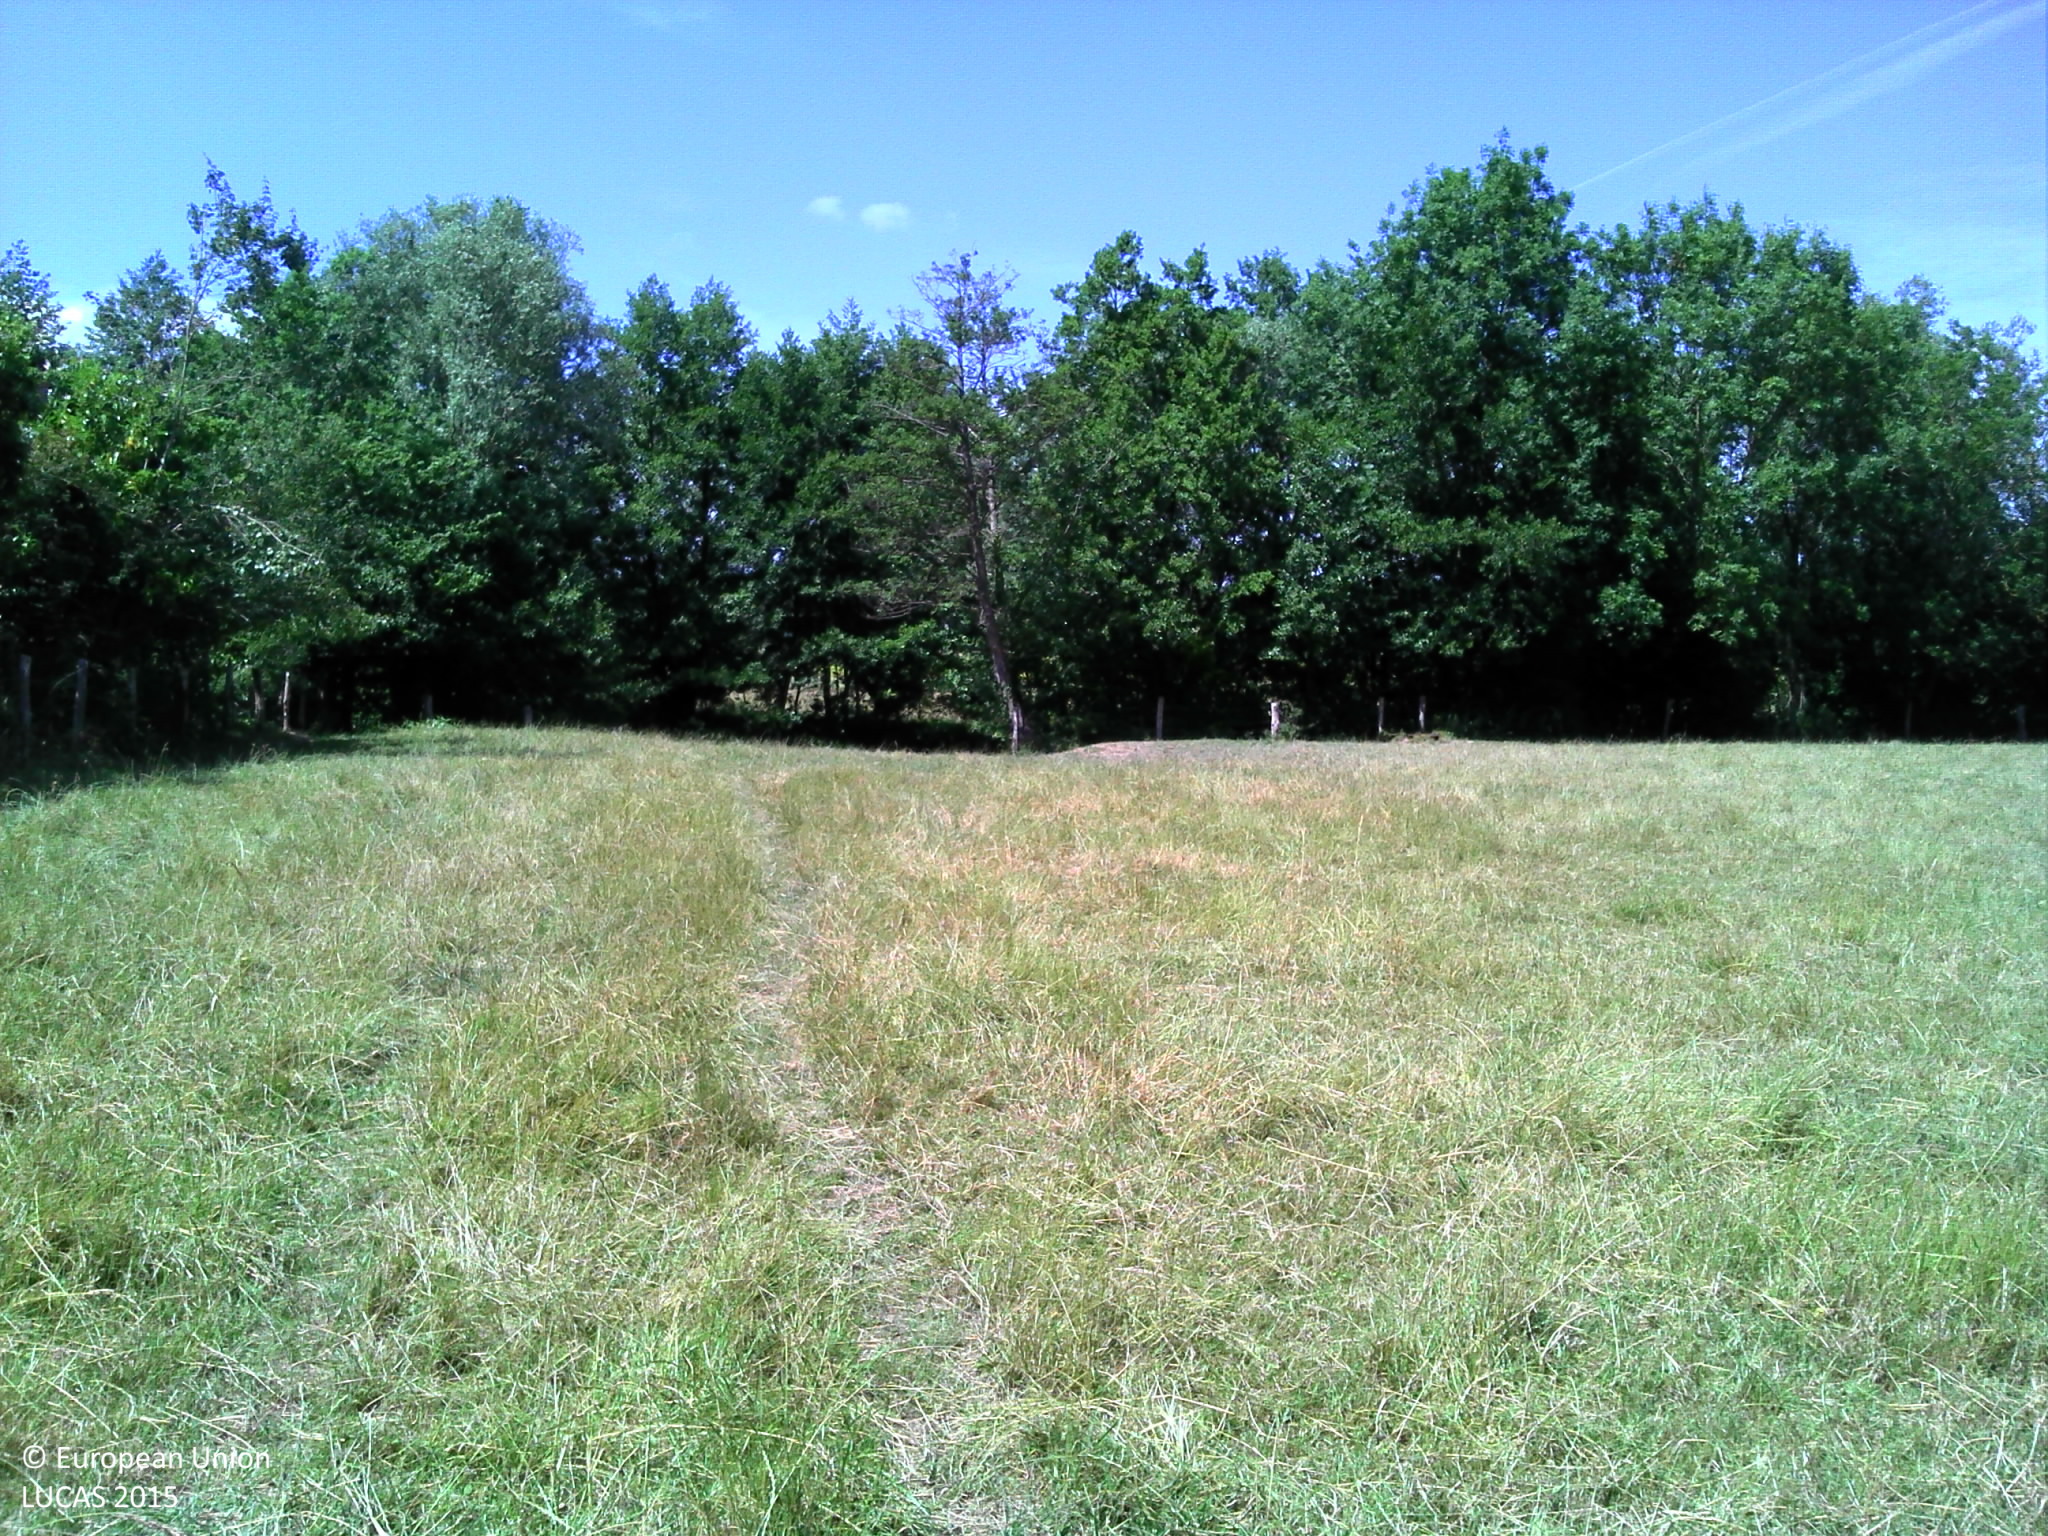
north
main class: Grassland
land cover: Grassland without tree/shrub cover
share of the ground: > 75 %
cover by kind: herbaceous plants 100 %
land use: Agriculture (excluding fallow land and kitchen gardens)
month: June
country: FR
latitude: 49.3222
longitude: 1.2435
